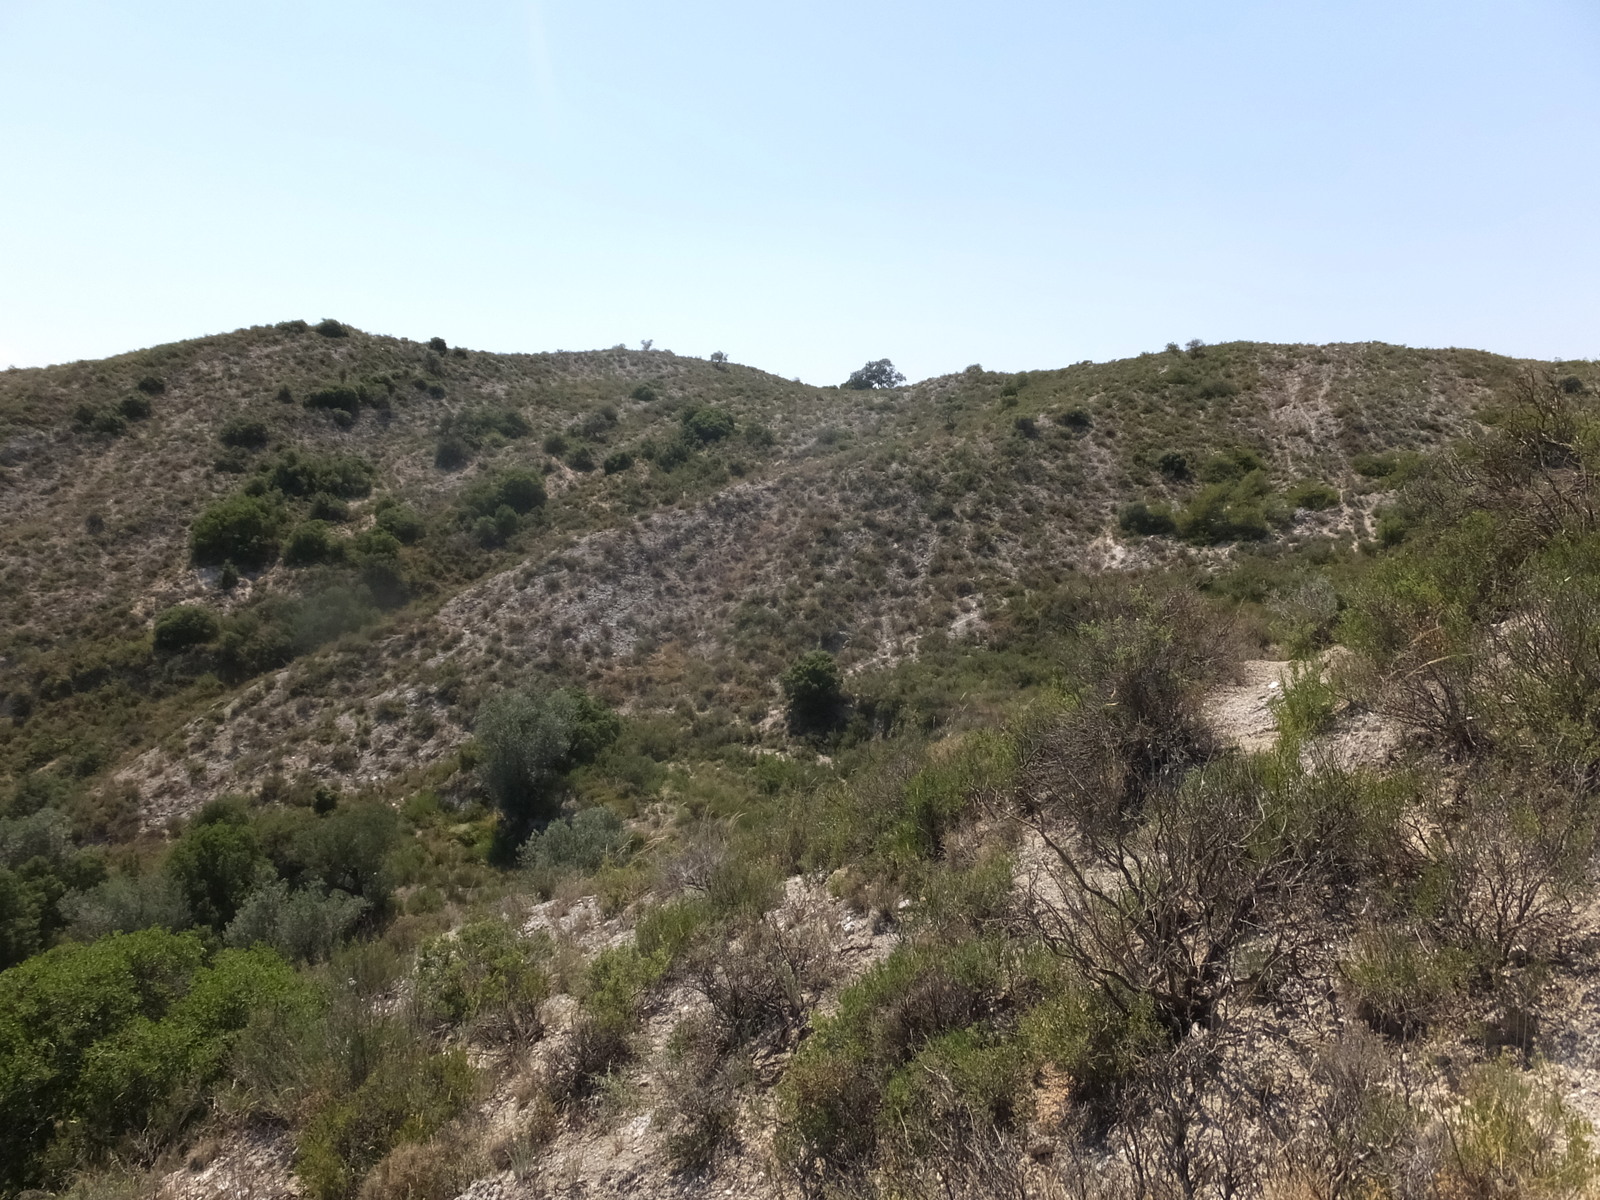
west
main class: Shrubland
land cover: Shrubland with sparse tree cover
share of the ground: 50 - 75 %
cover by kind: shrubs 50 %, herbaceous plants 25 %, consolidated bare surface 20 %, coniferous forest trees 5 %
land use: Semi-natural and natural areas not in use
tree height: < 5 m
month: June
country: ES
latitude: 41.8617
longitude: 0.5044
